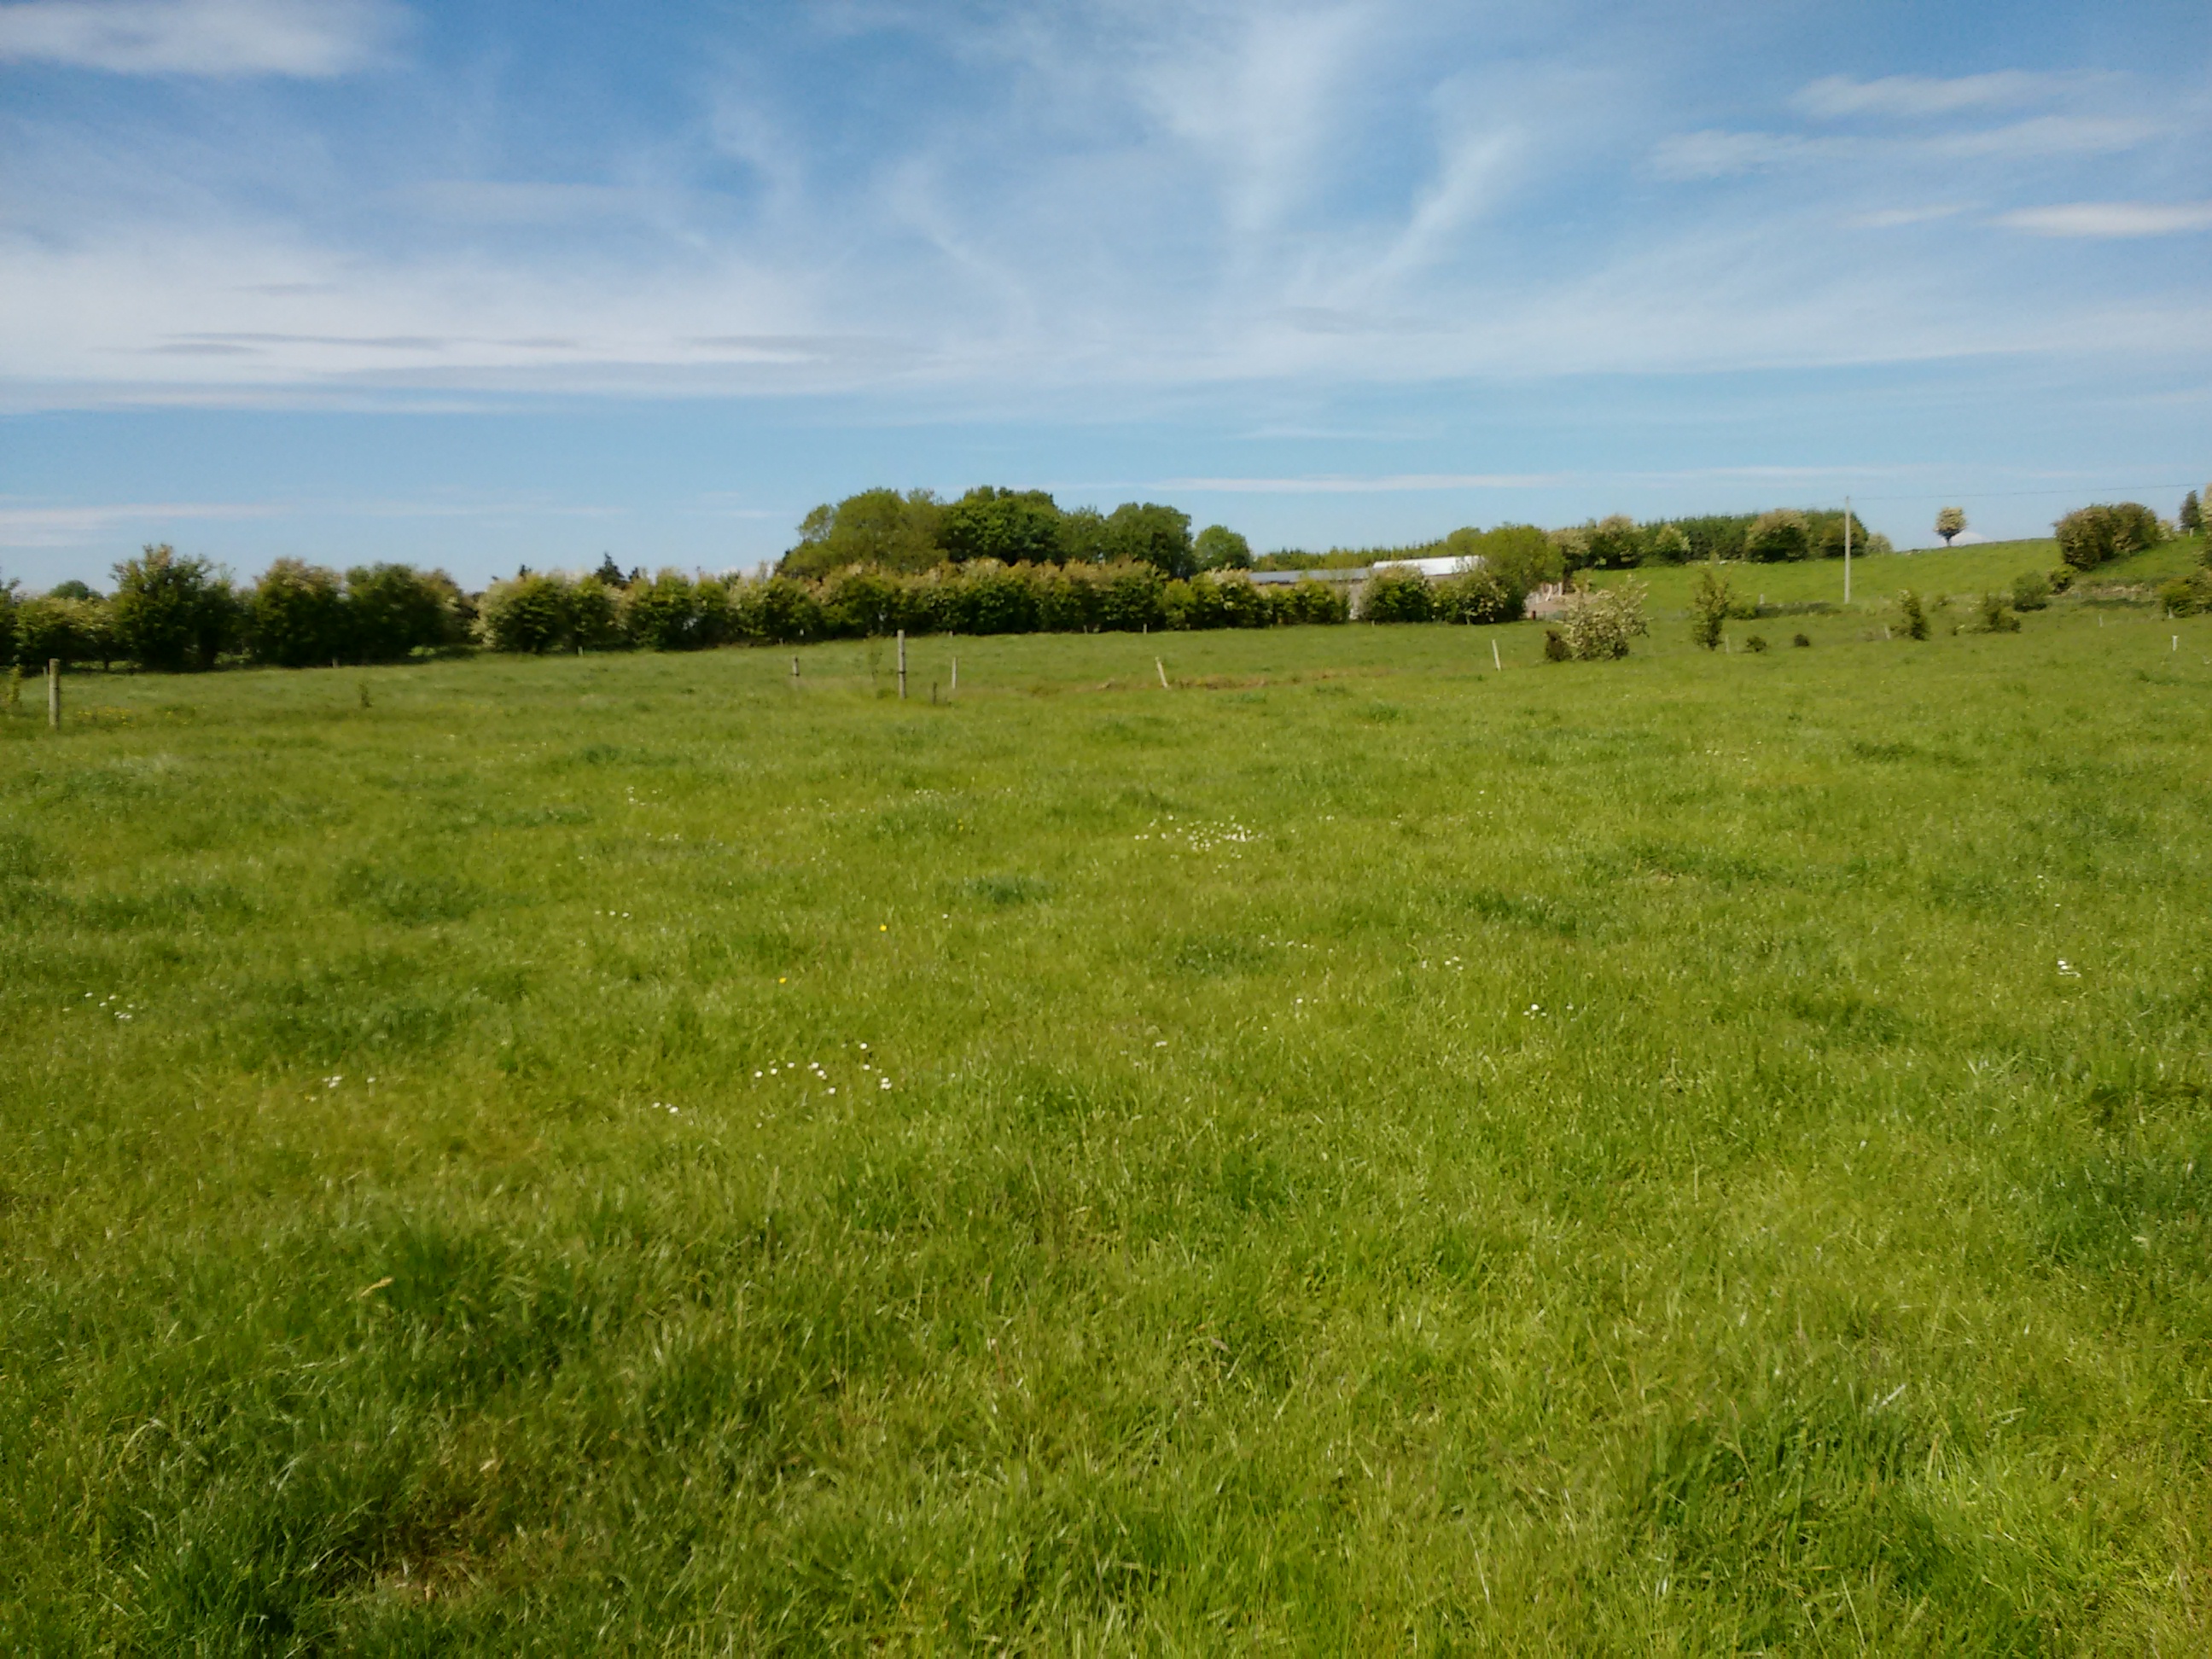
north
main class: Grassland
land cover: Grassland without tree/shrub cover
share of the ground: > 75 %
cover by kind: herbaceous plants 100 %
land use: Agriculture (excluding fallow land and kitchen gardens)
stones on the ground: < 10 %
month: June
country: IE
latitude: 53.4932
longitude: -8.7266
